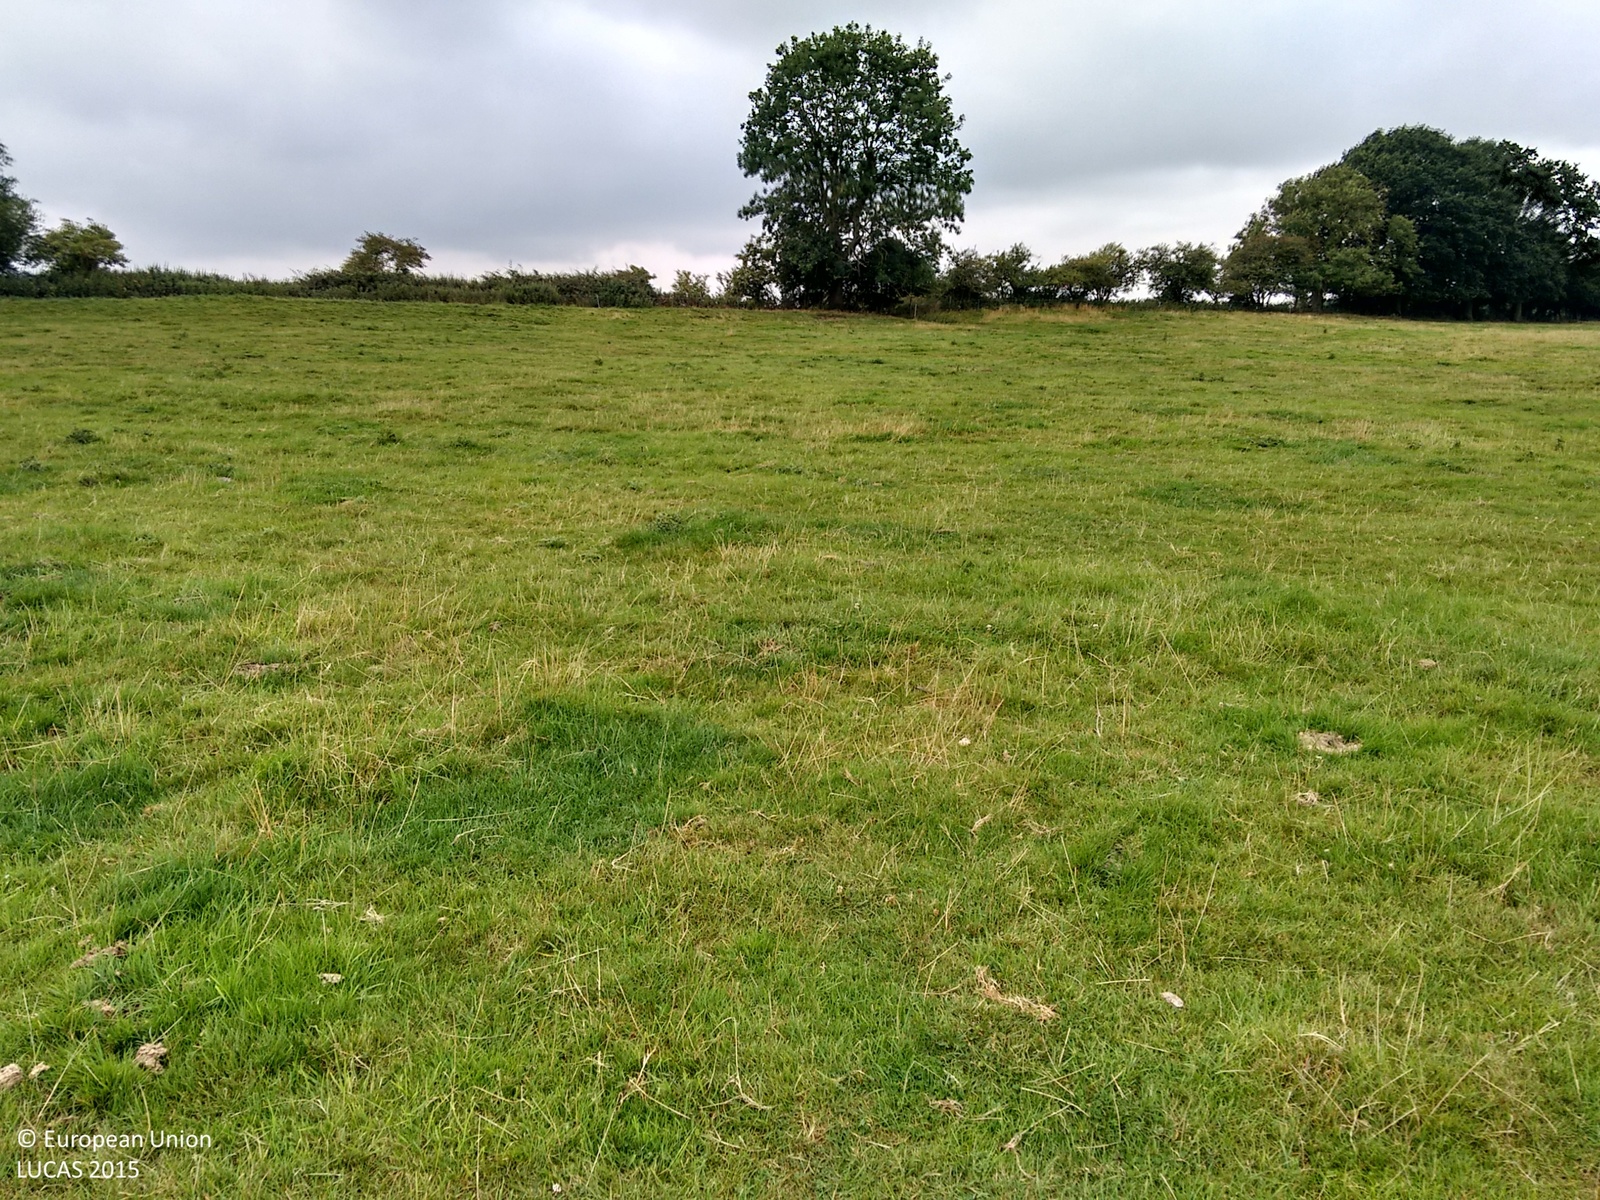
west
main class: Grassland
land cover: Grassland without tree/shrub cover
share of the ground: > 75 %
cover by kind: herbaceous plants 100 %
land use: Agriculture (excluding fallow land and kitchen gardens)
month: August
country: GB
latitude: 52.6450
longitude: 0.4690
